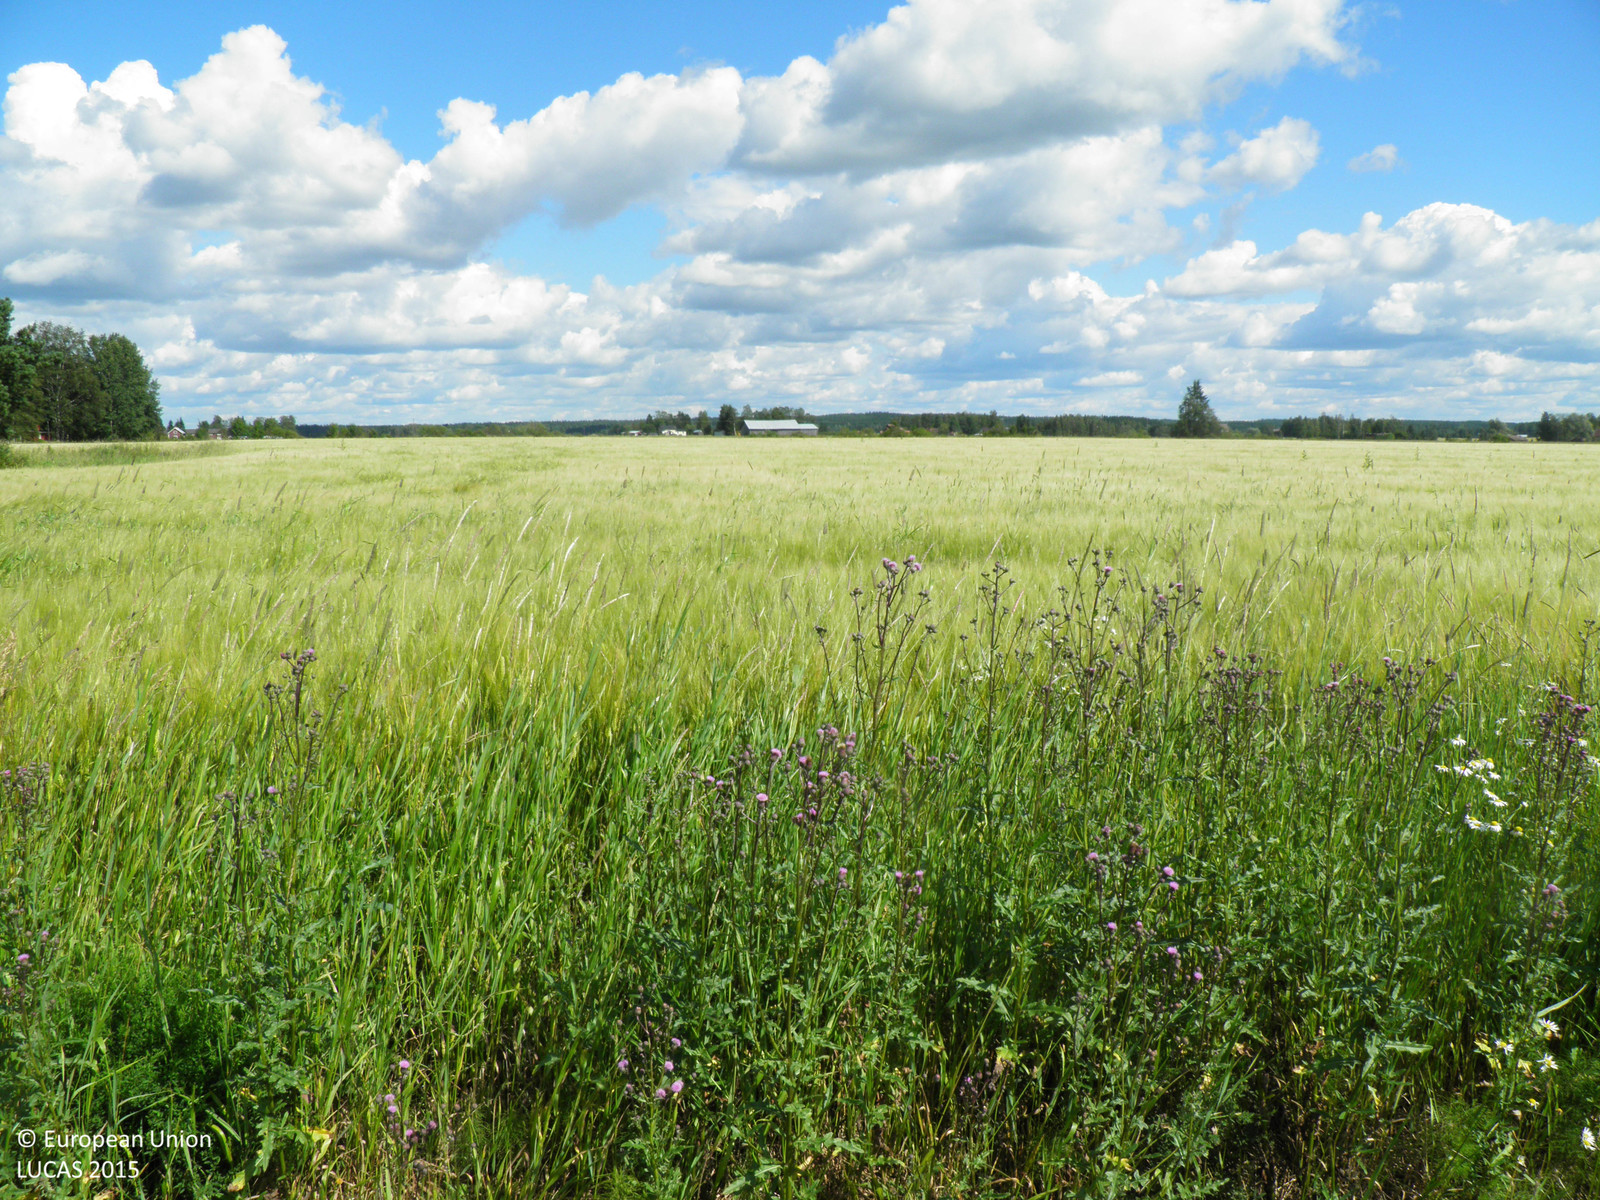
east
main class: Cropland
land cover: Barley
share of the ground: > 75 %
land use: Agriculture (excluding fallow land and kitchen gardens)
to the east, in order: Barley; Grass margins; Ditches and canals; Grass margins; Tracks; Barley
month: August
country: FI
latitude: 60.9492
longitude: 22.9792
